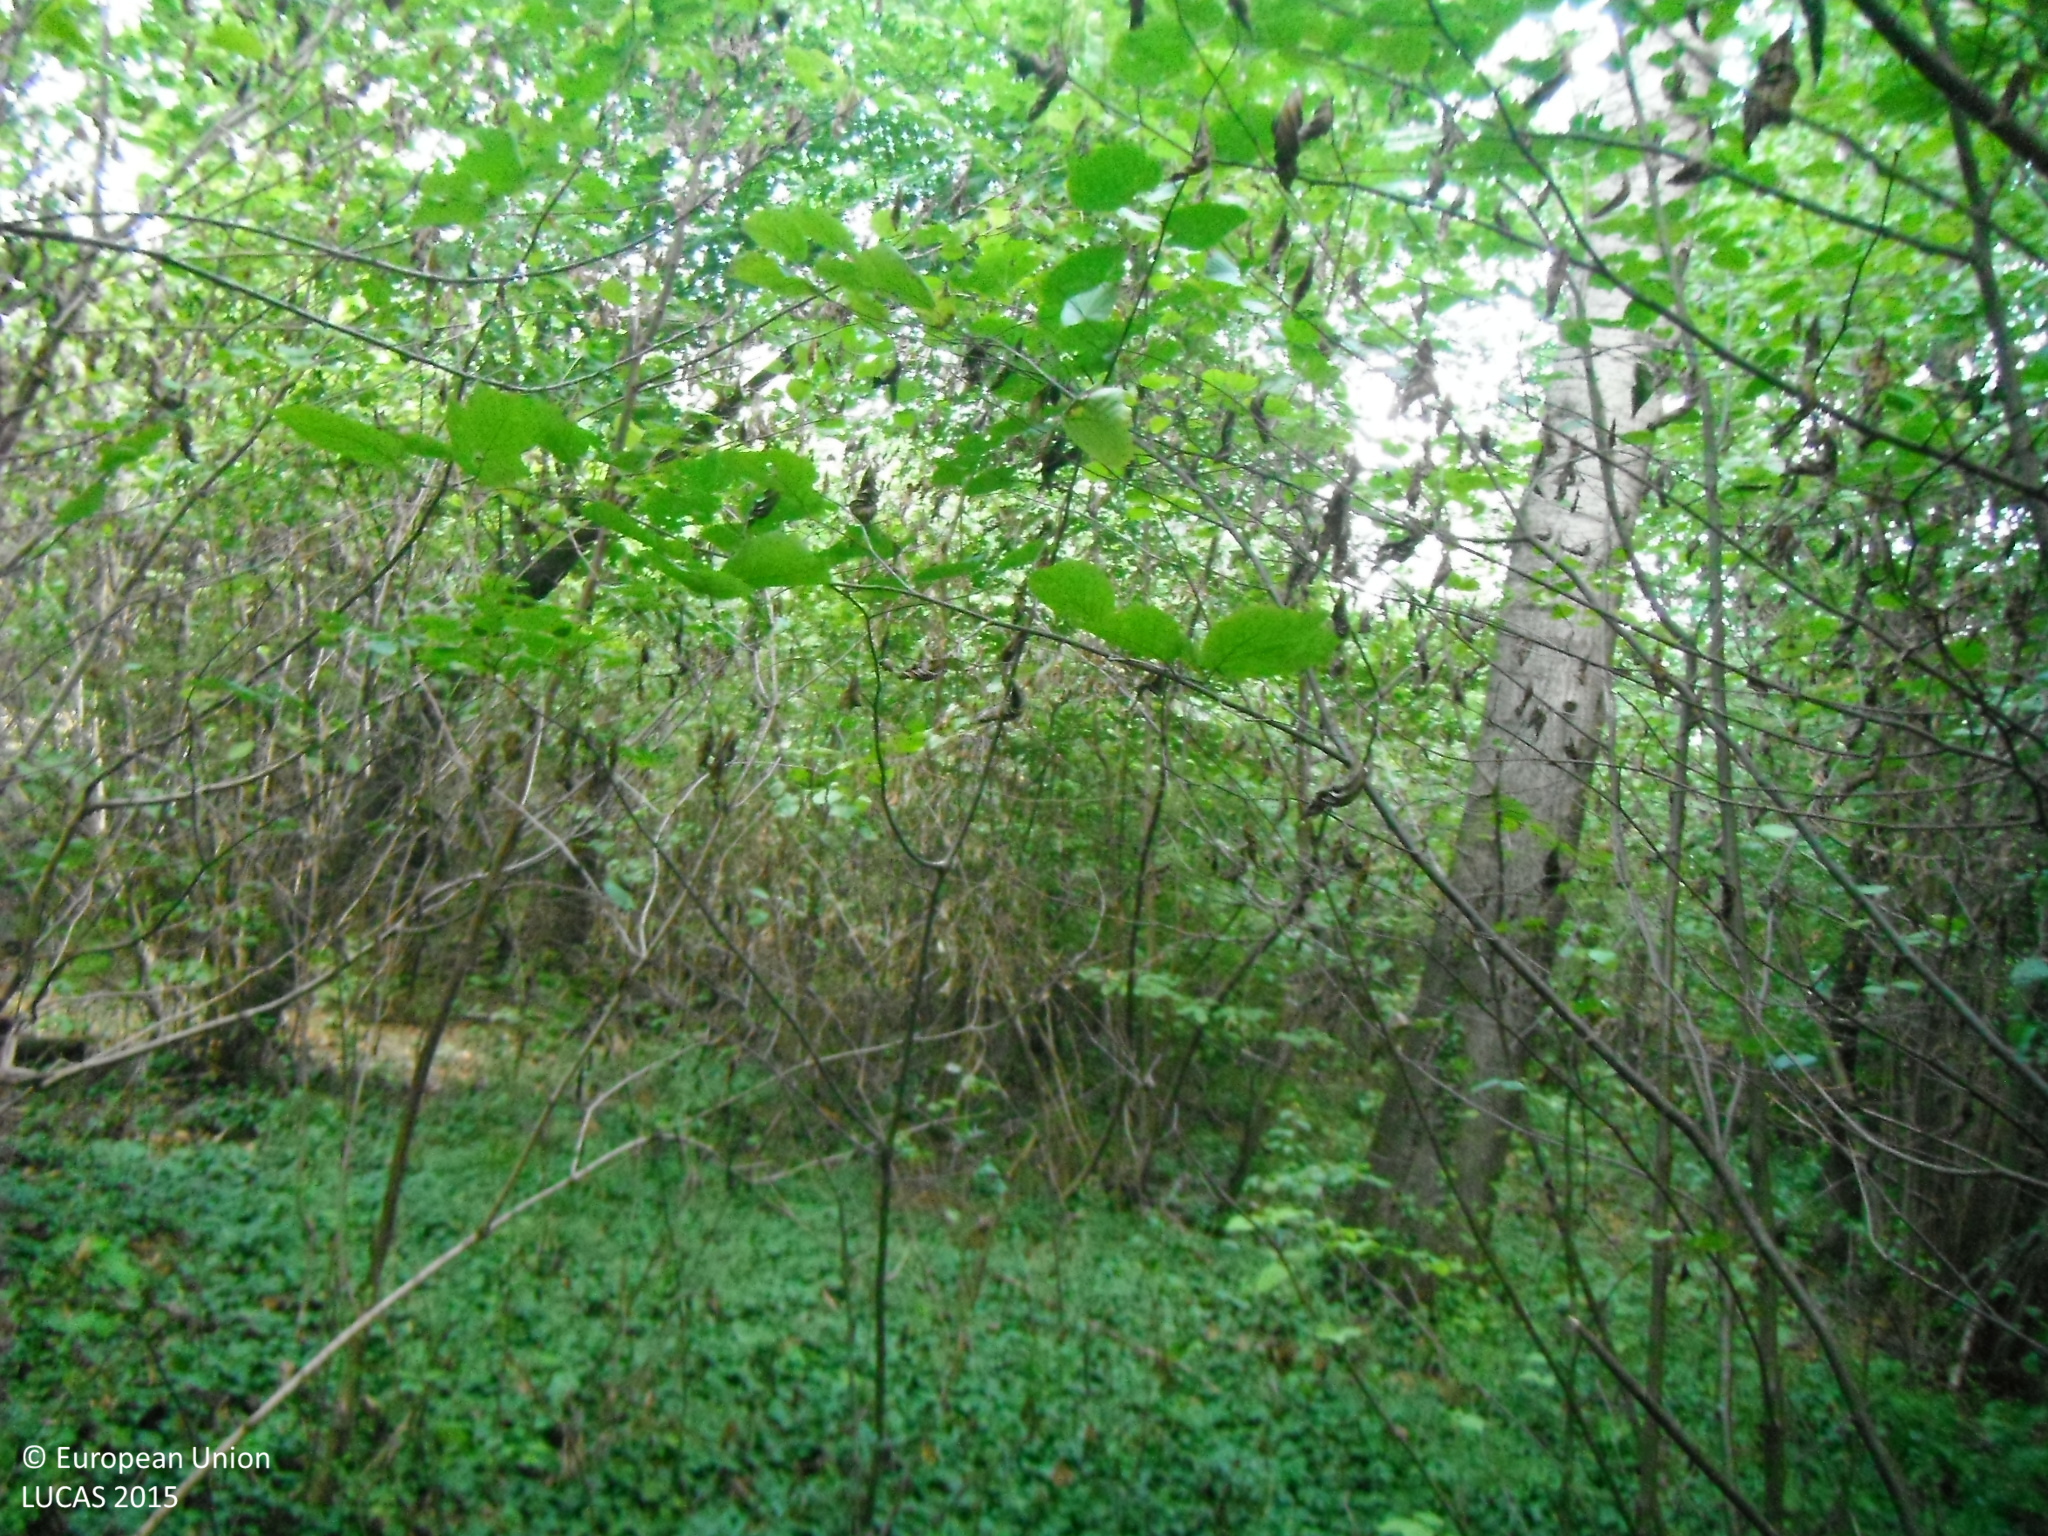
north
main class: Woodland
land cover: Broadleaved woodland
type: mesophytic deciduous forest
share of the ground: > 75 %
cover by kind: broadleaved forest trees 100 %
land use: Forestry
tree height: > 5 m
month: September
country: SK
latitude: 48.9230
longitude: 18.0532
